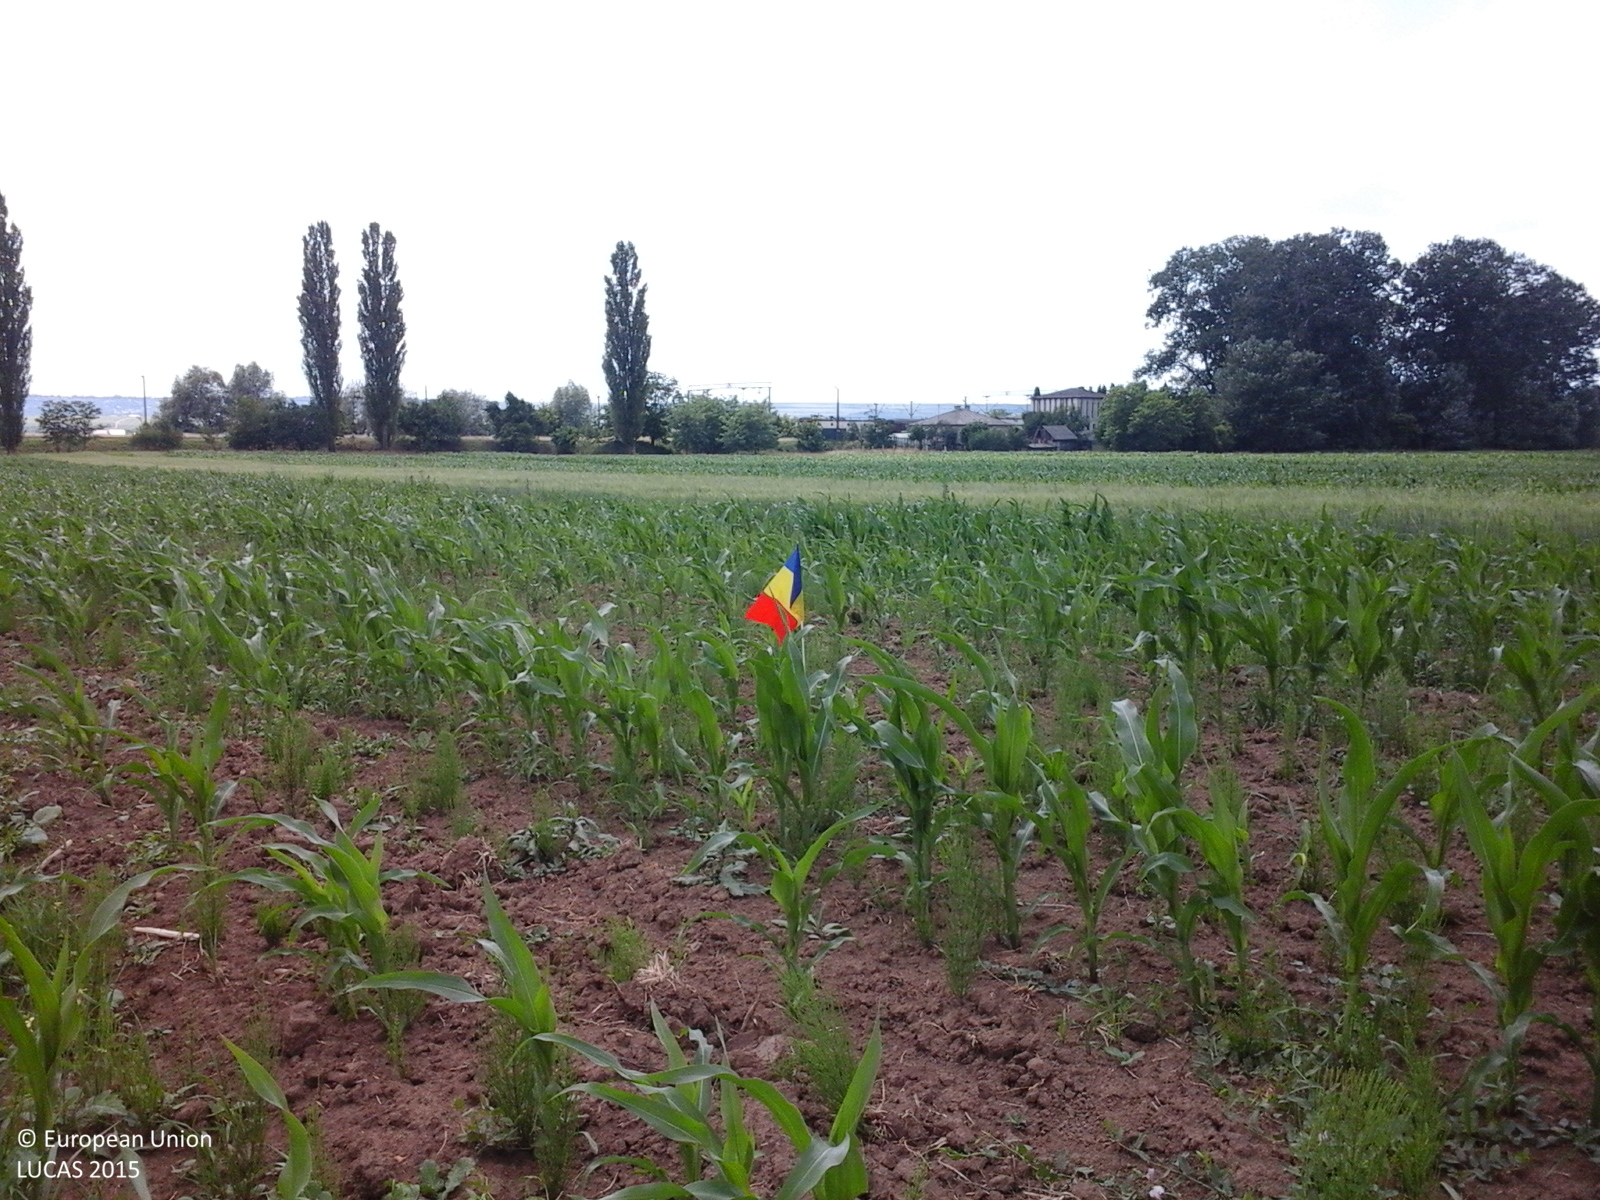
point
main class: Cropland
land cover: Maize
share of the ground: 50 - 75 %
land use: Agriculture (excluding fallow land and kitchen gardens)
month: June
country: RO
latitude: 47.6325
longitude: 26.3624
